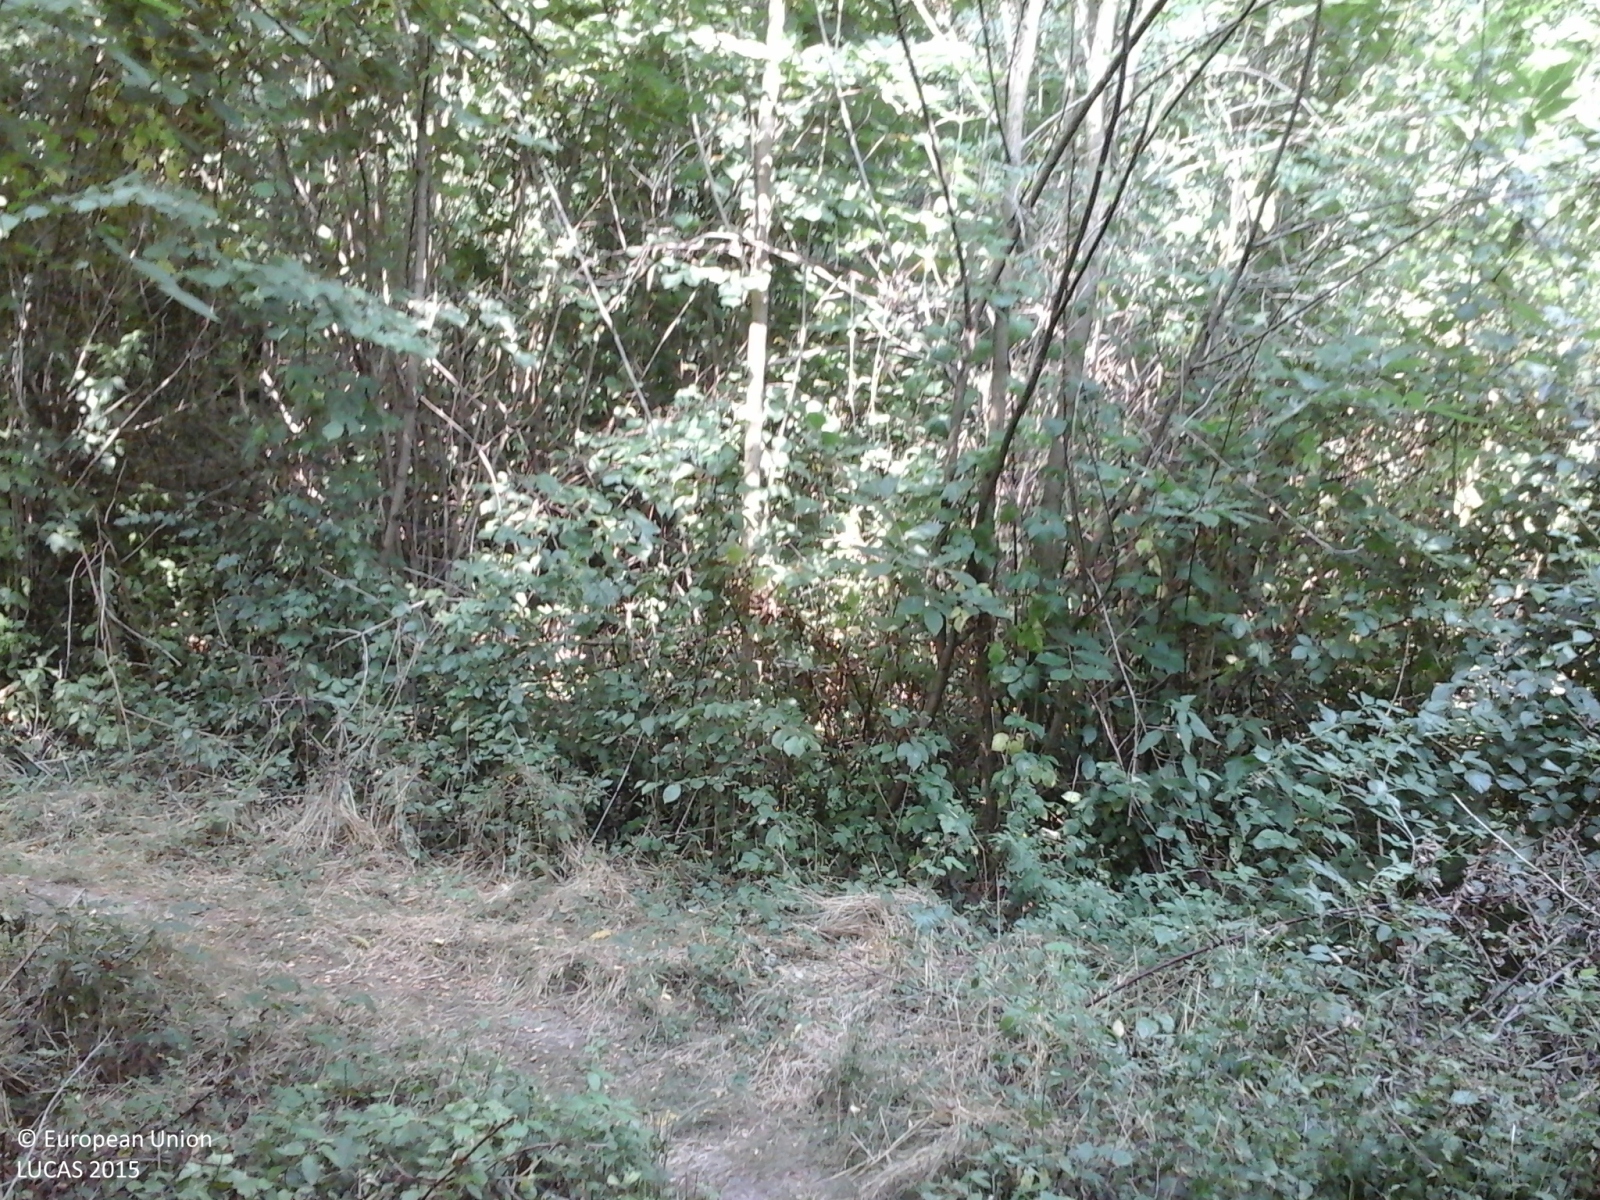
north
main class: Woodland
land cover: Broadleaved woodland
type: thermophilous deciduous forest
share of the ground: > 75 %
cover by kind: broadleaved forest trees 100 %
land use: Forestry
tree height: > 5 m
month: July
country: IT
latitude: 45.3907
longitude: 7.7683
